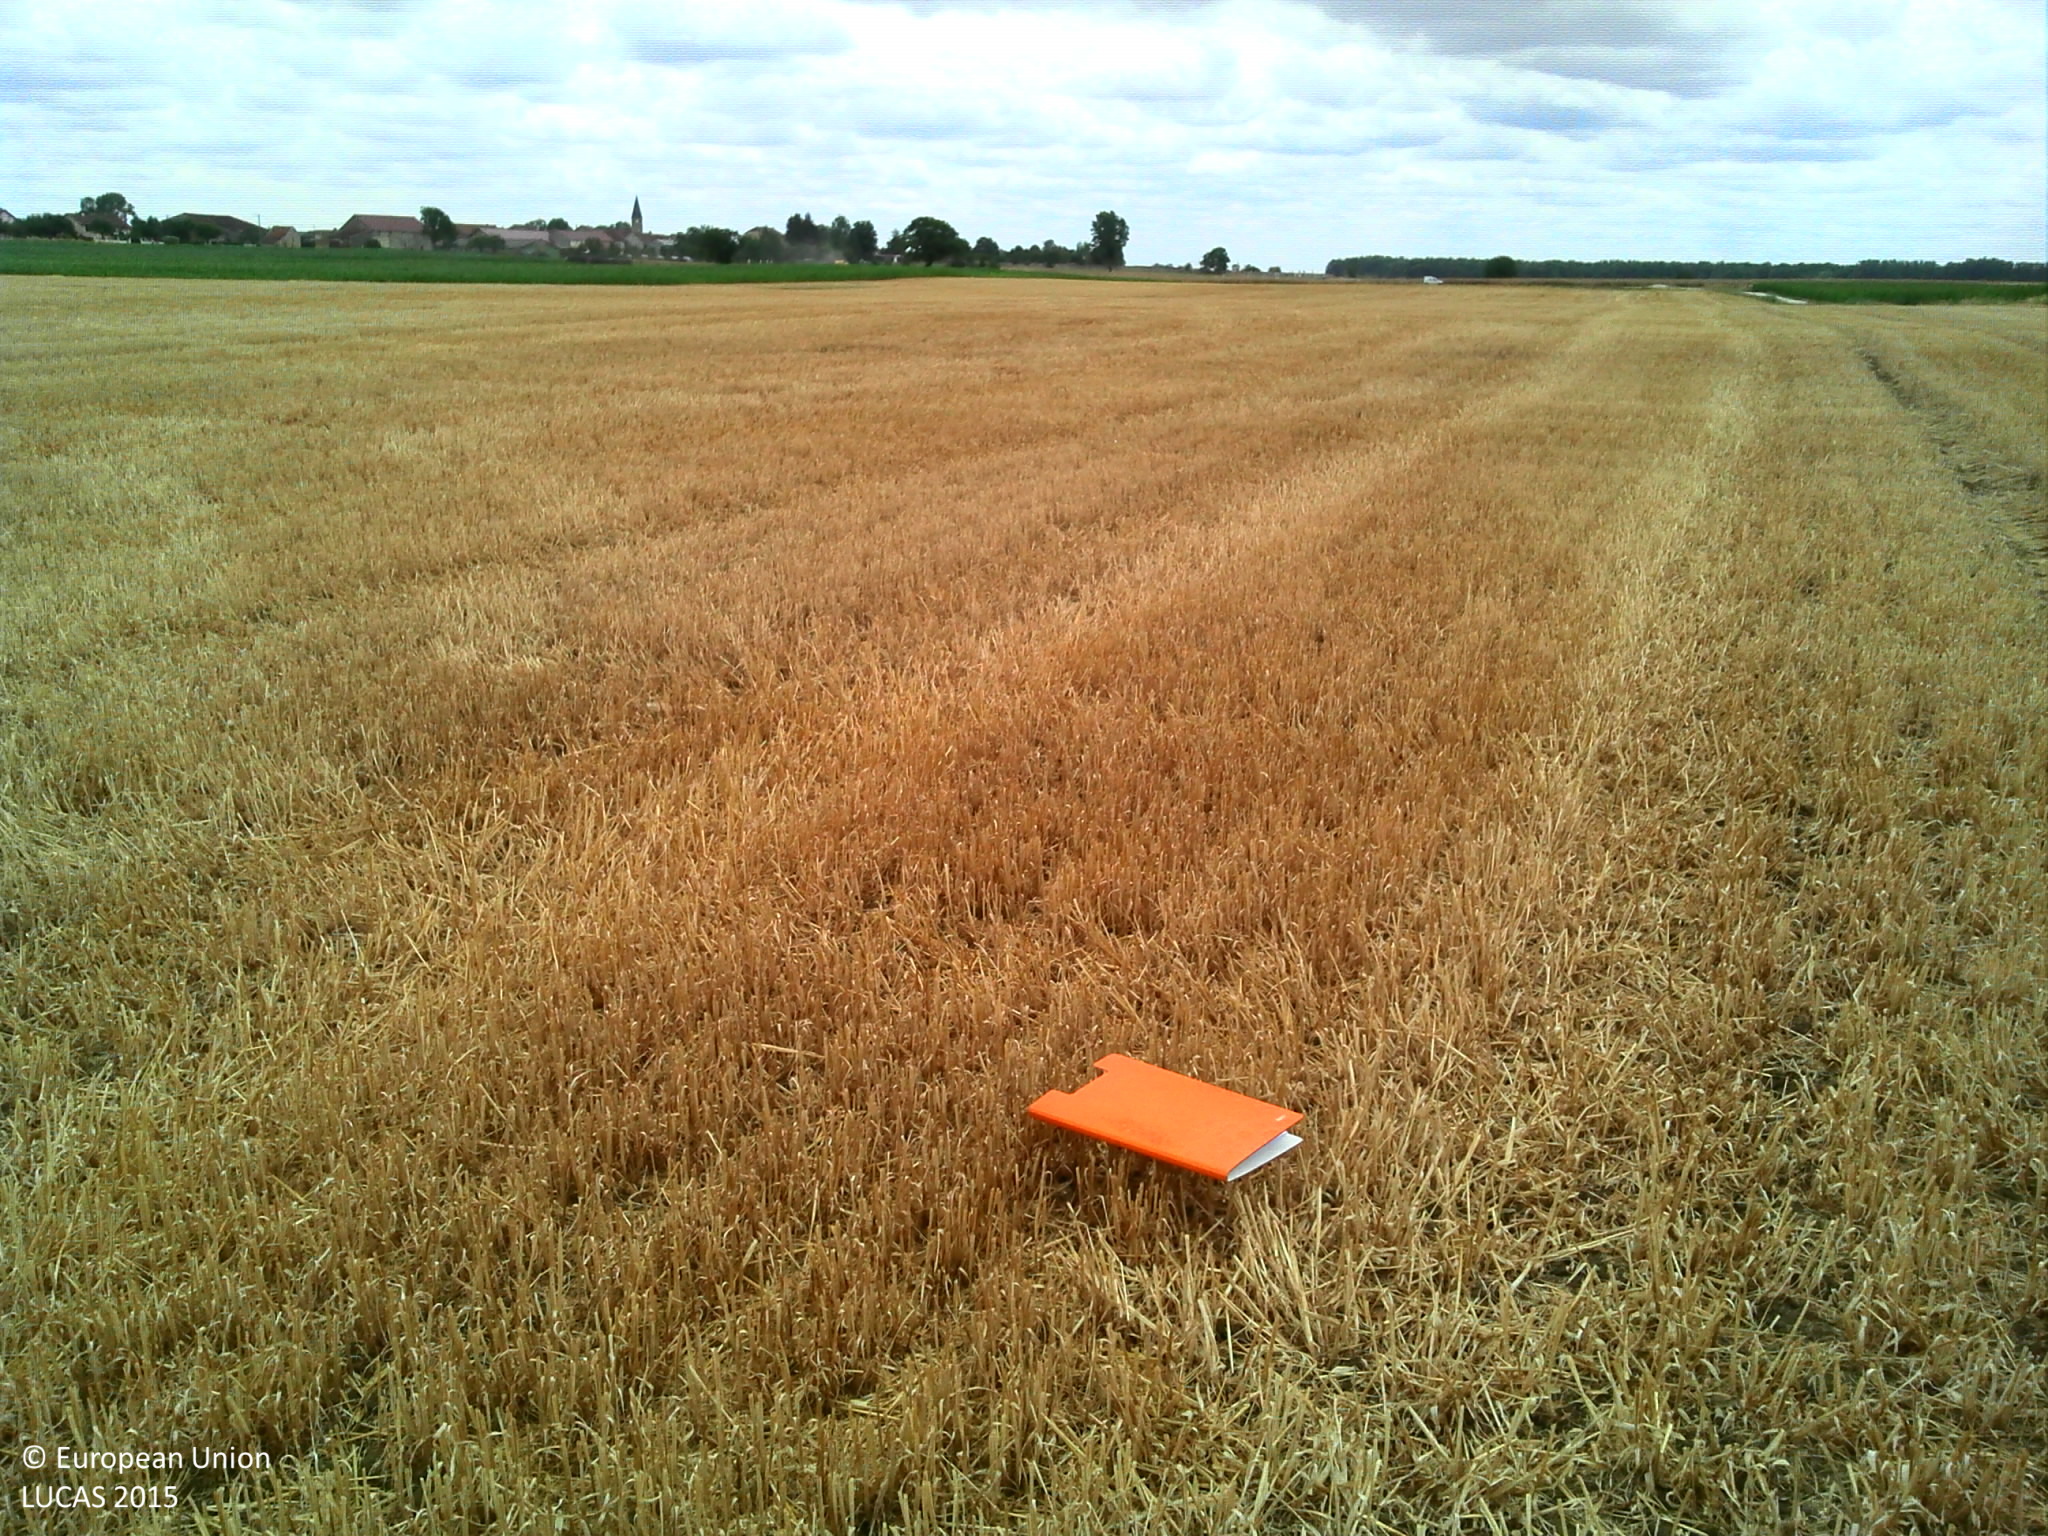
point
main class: Cropland
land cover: Barley
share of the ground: 25 - 50 %
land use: Agriculture (excluding fallow land and kitchen gardens)
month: July
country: FR
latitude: 48.1683
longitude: 5.0912
